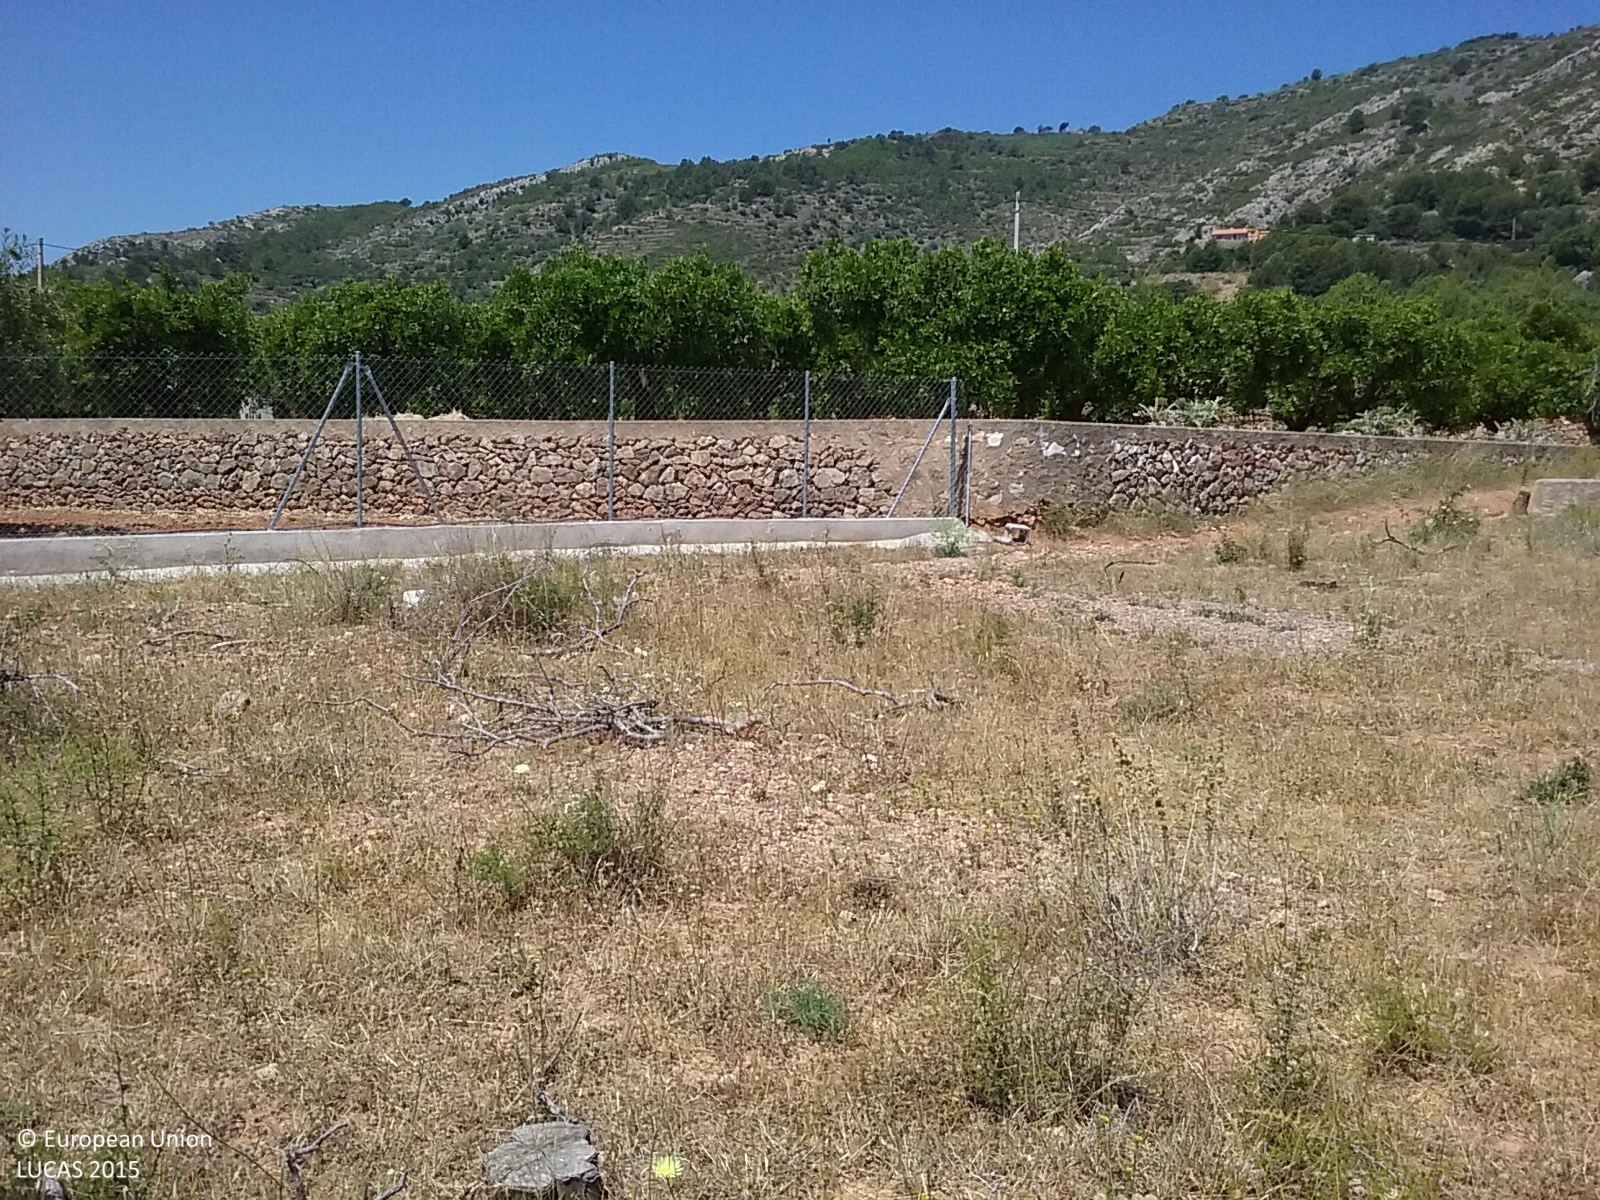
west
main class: Shrubland
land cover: Shrubland without tree cover
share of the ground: 10 - 25 %
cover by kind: herbaceous plants 80 %, shrubs 15 %, unconsolidated bare surface 5 %
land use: Abandoned areas
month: June
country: ES
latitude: 40.0598
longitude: -0.0488
